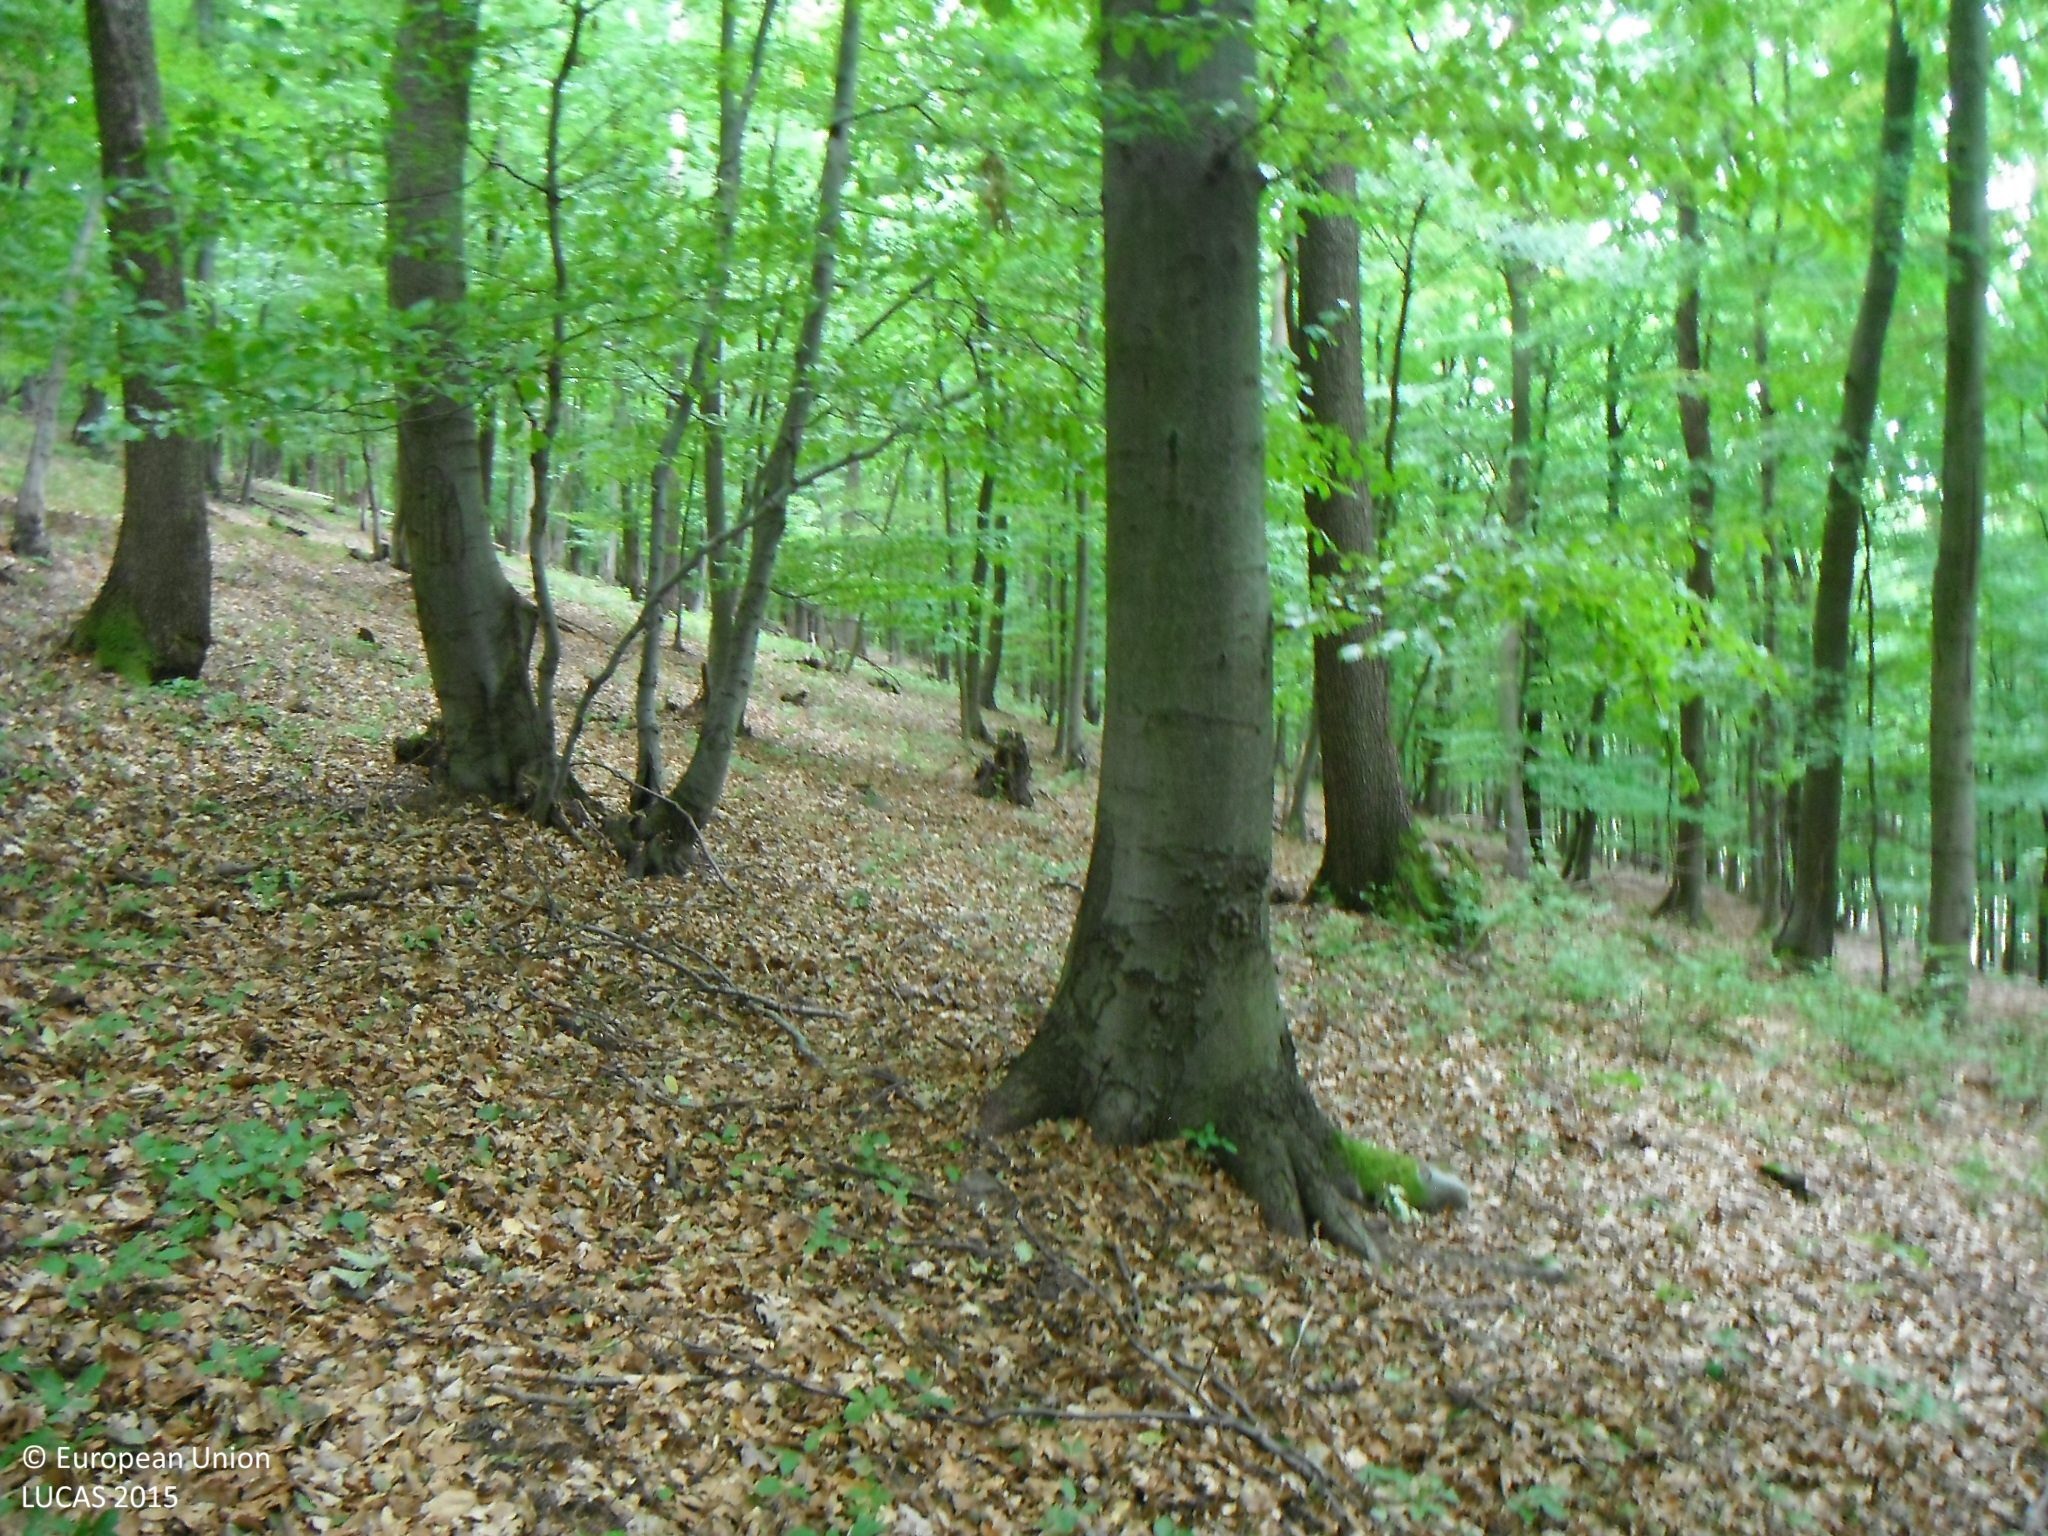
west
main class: Woodland
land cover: Broadleaved woodland
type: beech forest
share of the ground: > 75 %
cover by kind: broadleaved forest trees 100 %
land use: Forestry
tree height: > 5 m
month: July
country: SK
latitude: 48.2588
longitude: 19.9830
